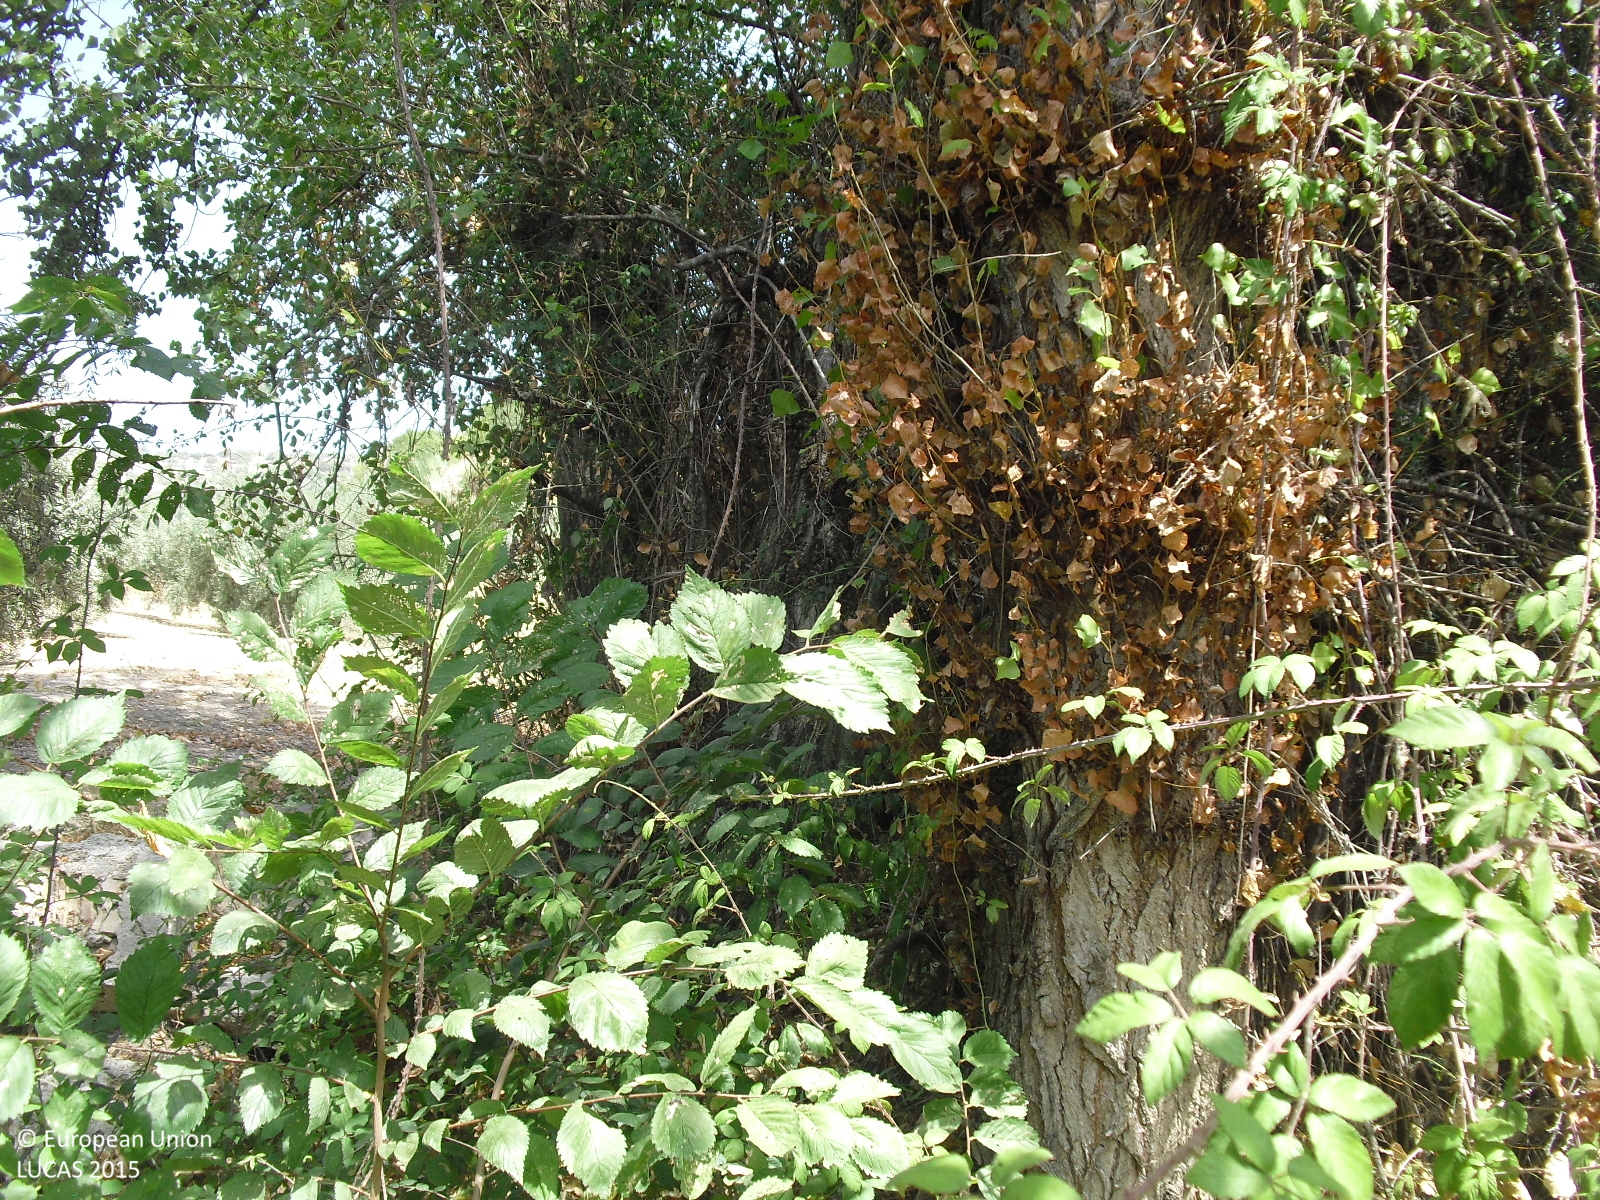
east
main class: Woodland
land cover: Broadleaved woodland
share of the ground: > 75 %
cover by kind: broadleaved forest trees 80 %, shrubs 20 %
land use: Semi-natural and natural areas not in use
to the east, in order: Broadleaved woodland; Olive groves; Grassland without tree/shrub cover; Tracks; Olive groves; Grassland with sparse tree/shrub cover; Artificial constructions in urban areas
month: August
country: ES
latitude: 37.2507
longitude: -4.1678
